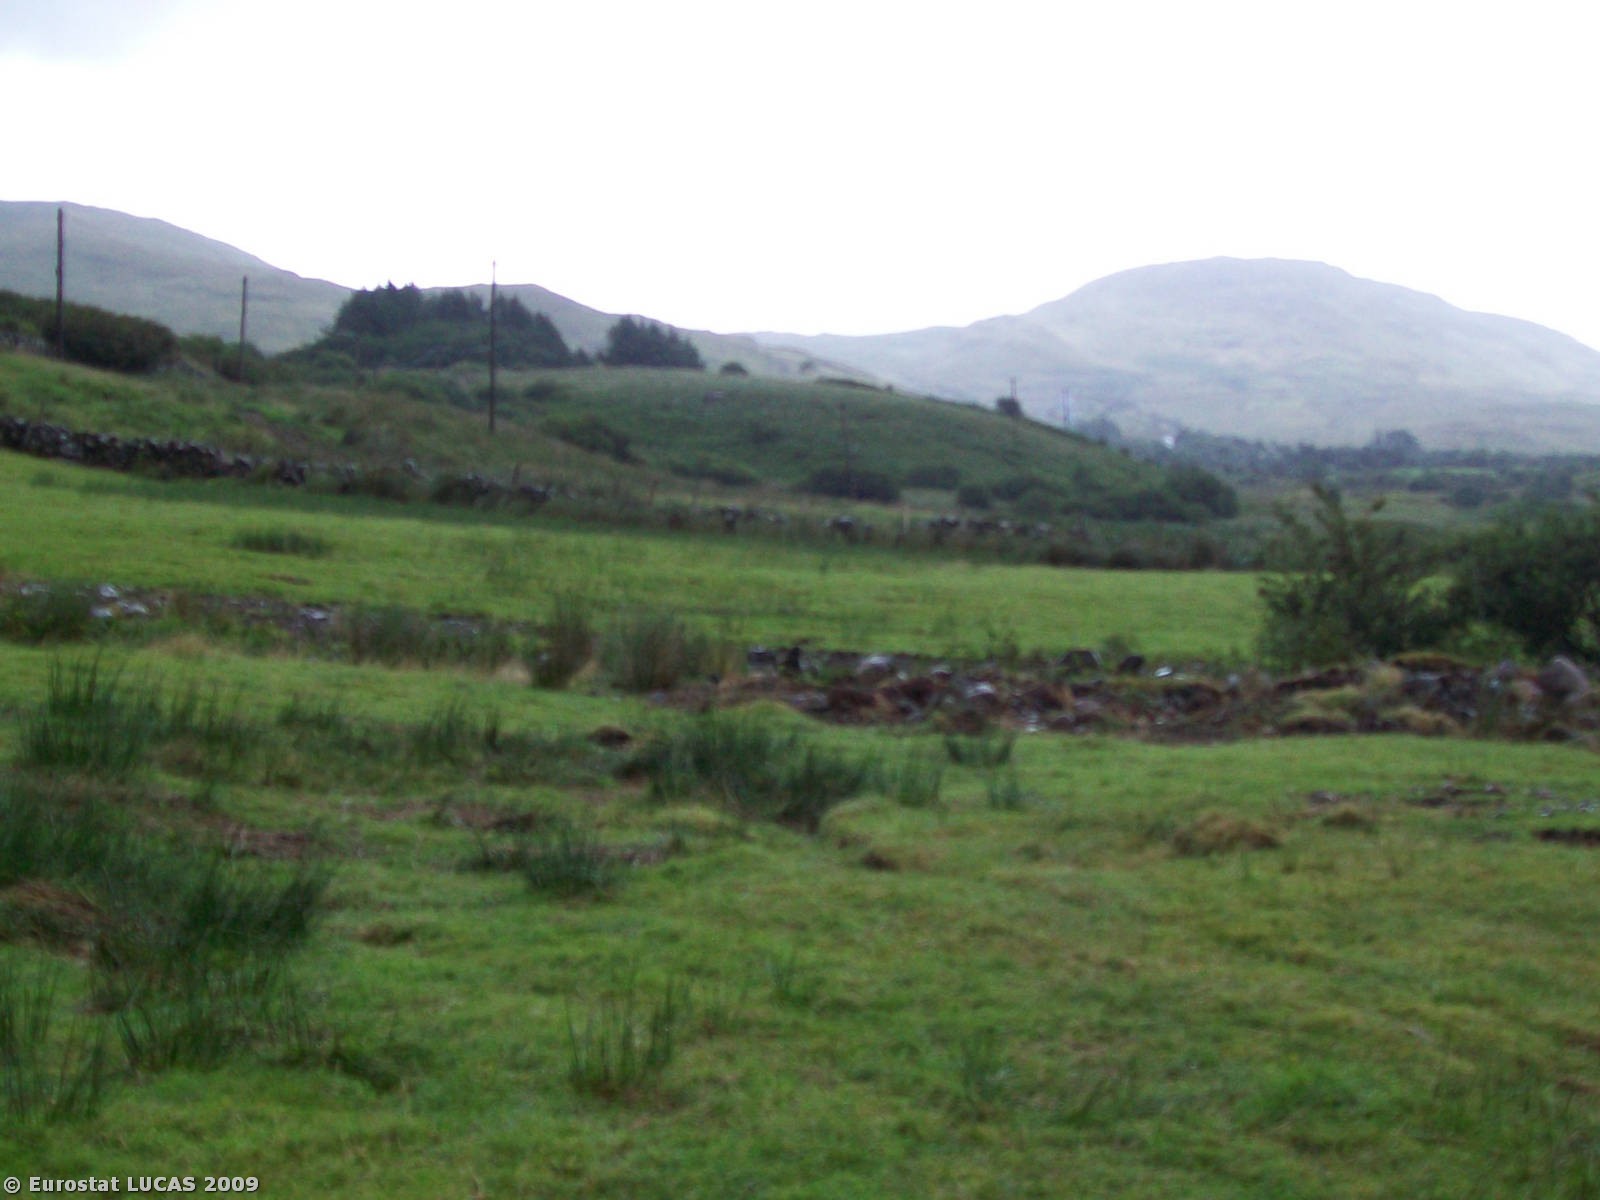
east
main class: Grassland
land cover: Grassland without tree/shrub cover
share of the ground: > 75 %
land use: Agriculture (excluding fallow land and kitchen gardens)
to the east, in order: Grassland without tree/shrub cover; Ditches and canals; Grassland without tree/shrub cover; Dry stone walls; Grassland without tree/shrub cover
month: July
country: IE
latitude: 53.5309
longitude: -9.5293
